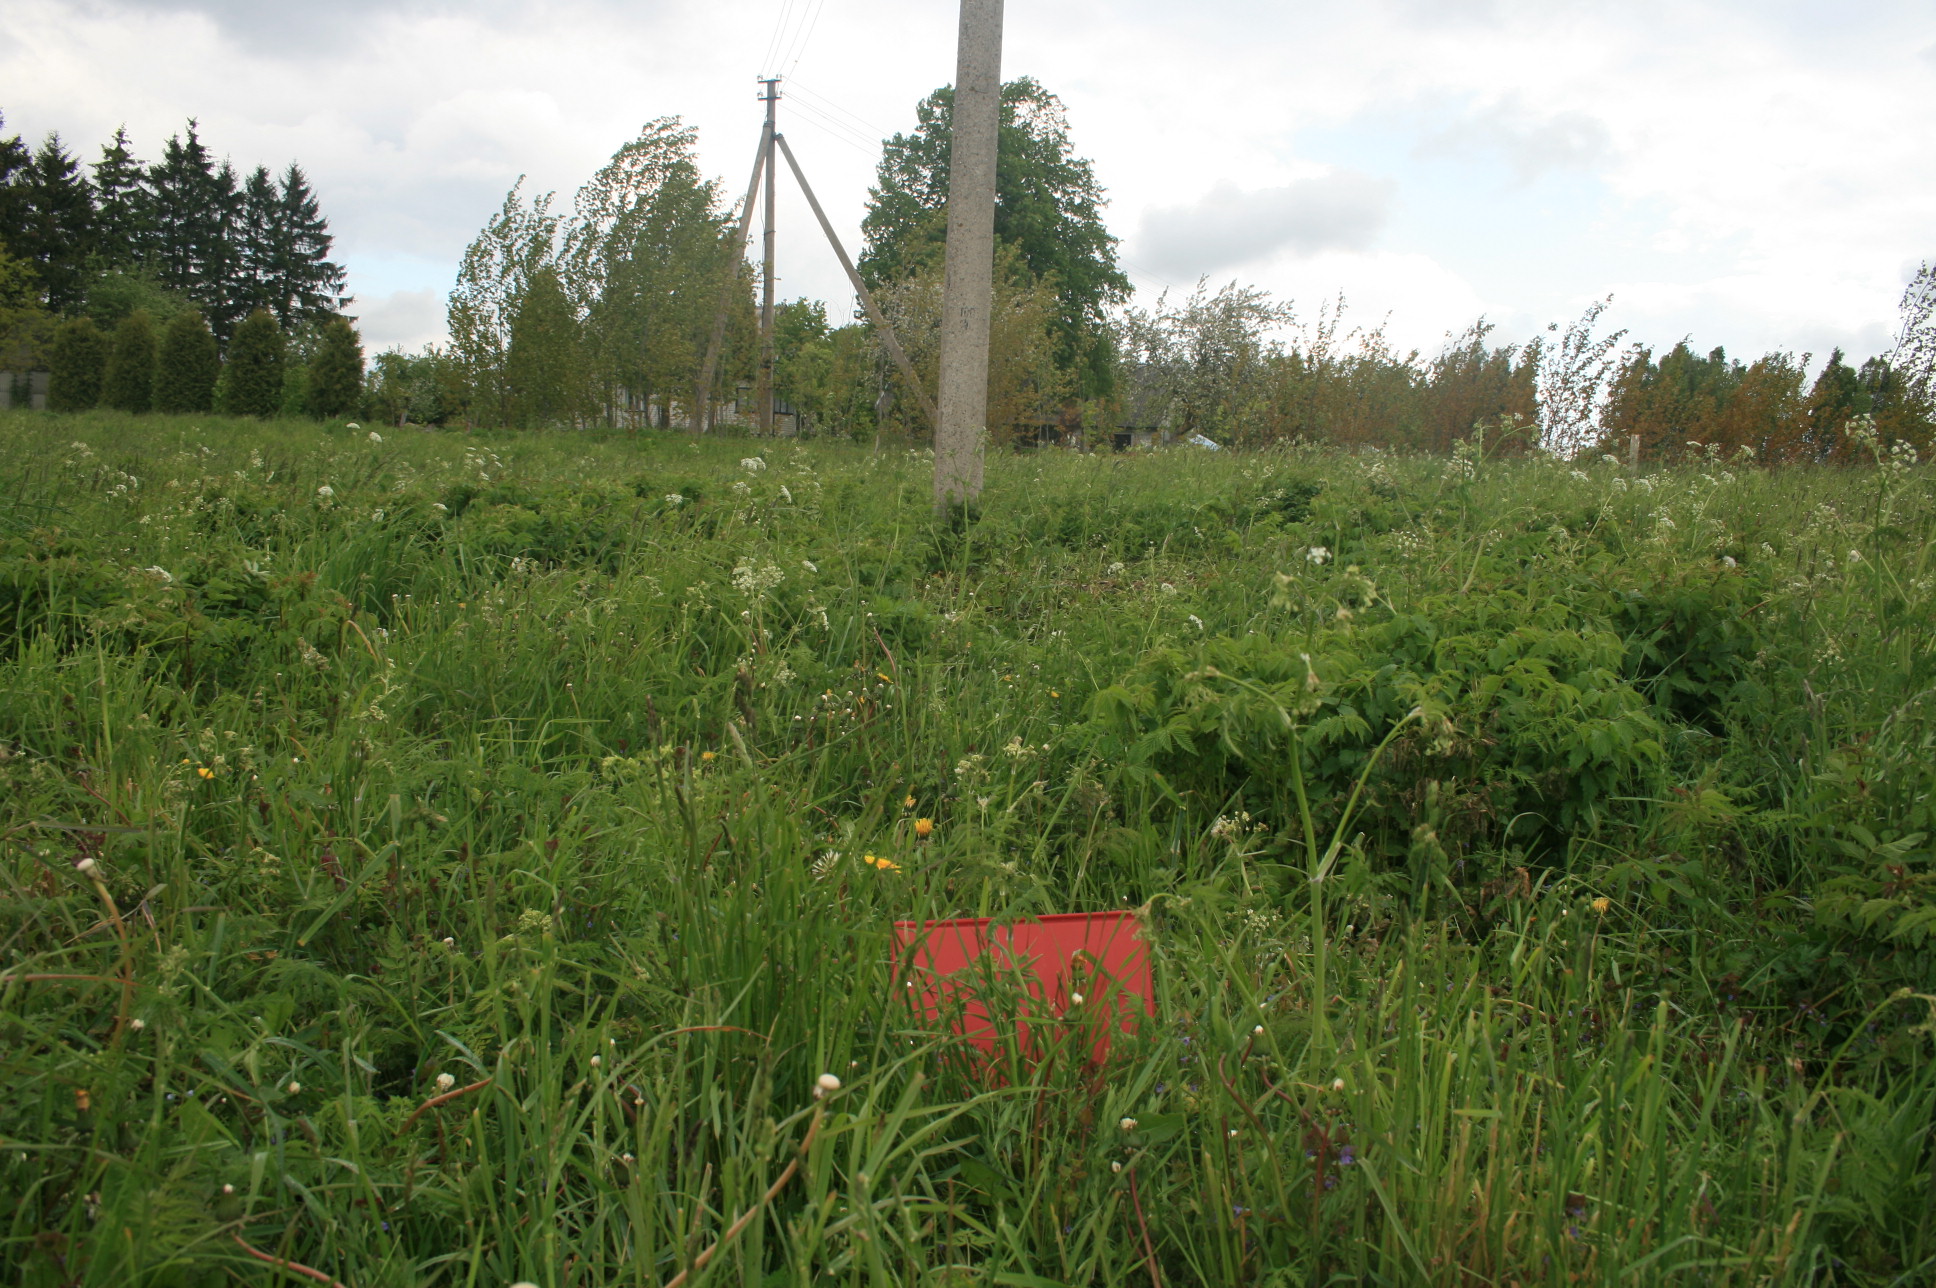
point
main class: Grassland
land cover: Grassland without tree/shrub cover
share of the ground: > 75 %
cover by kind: herbaceous plants 100 %
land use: Agriculture (excluding fallow land and kitchen gardens)
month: May
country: LT
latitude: 55.9250
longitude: 21.8765
